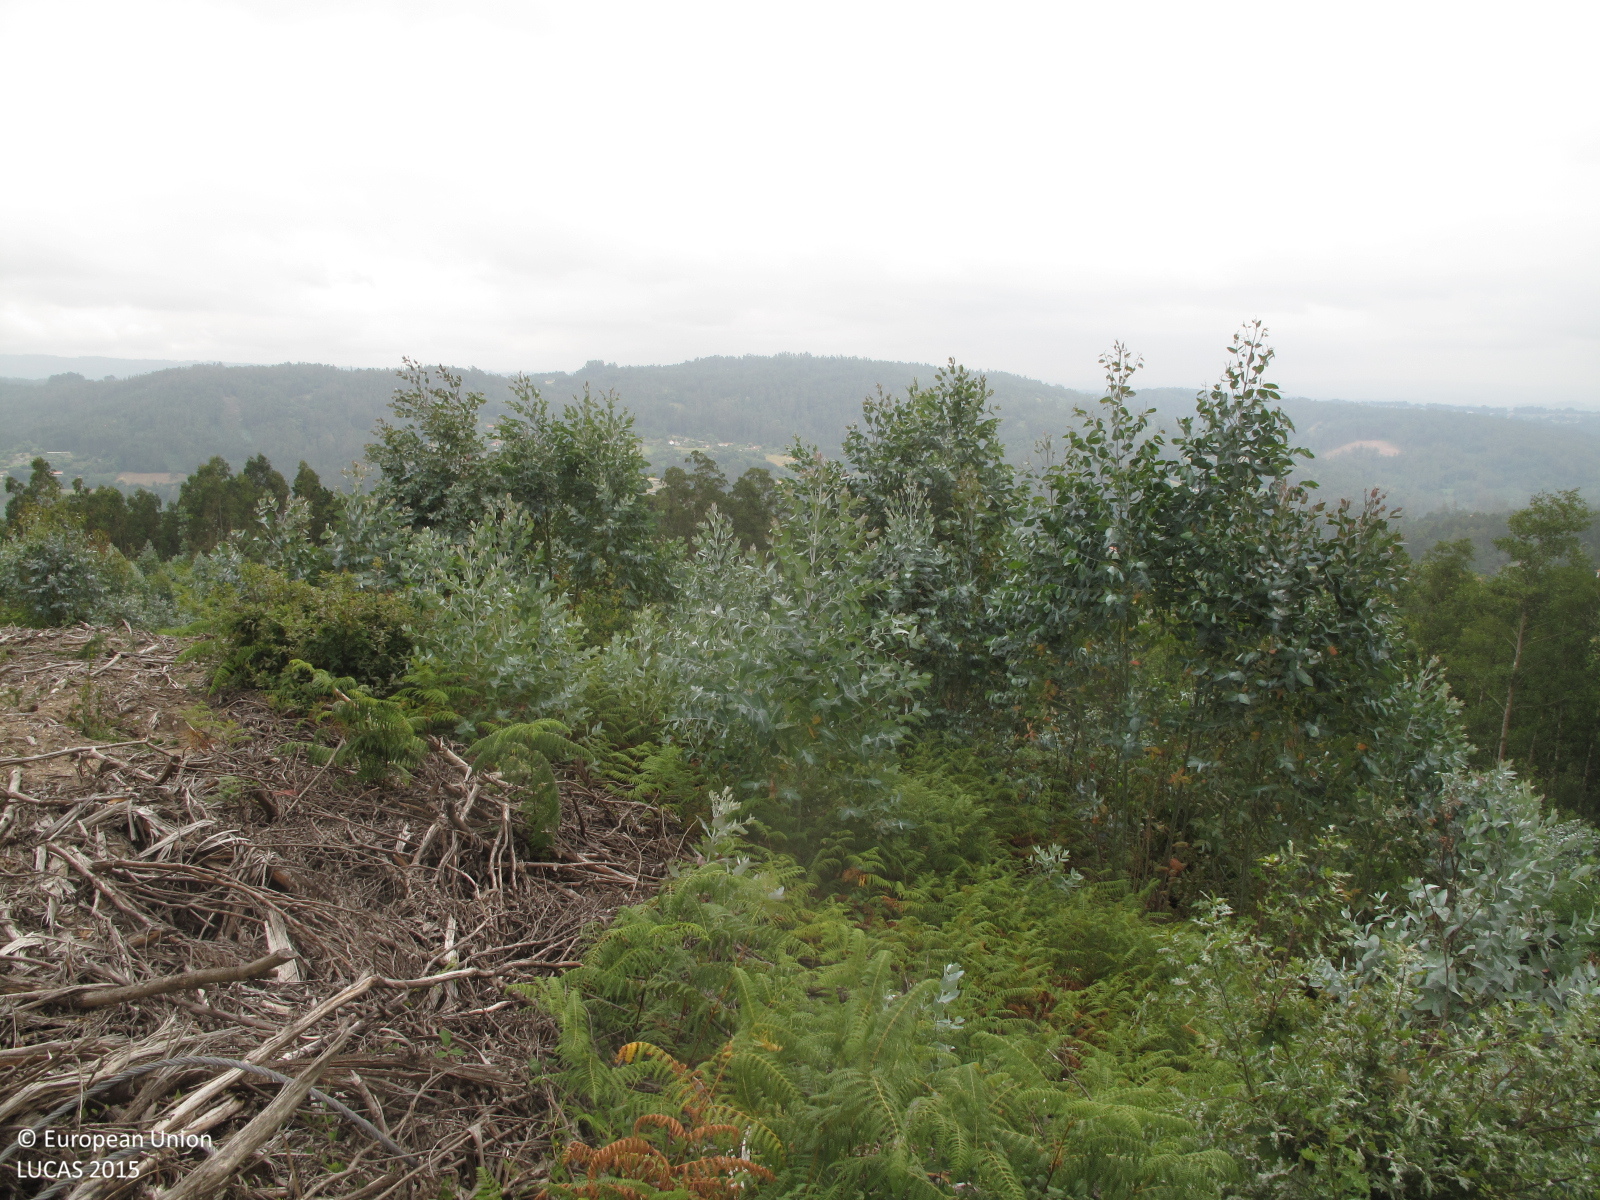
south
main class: Woodland
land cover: Broadleaved woodland
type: exotic forest
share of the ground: 10 - 25 %
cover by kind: herbaceous plants 40 %, broadleaved forest trees 20 %, shrubs 20 %, unconsolidated bare surface 20 %
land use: Forestry
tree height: < 5 m
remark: Clear cut
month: July
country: ES
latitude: 43.3824
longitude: -8.1326
